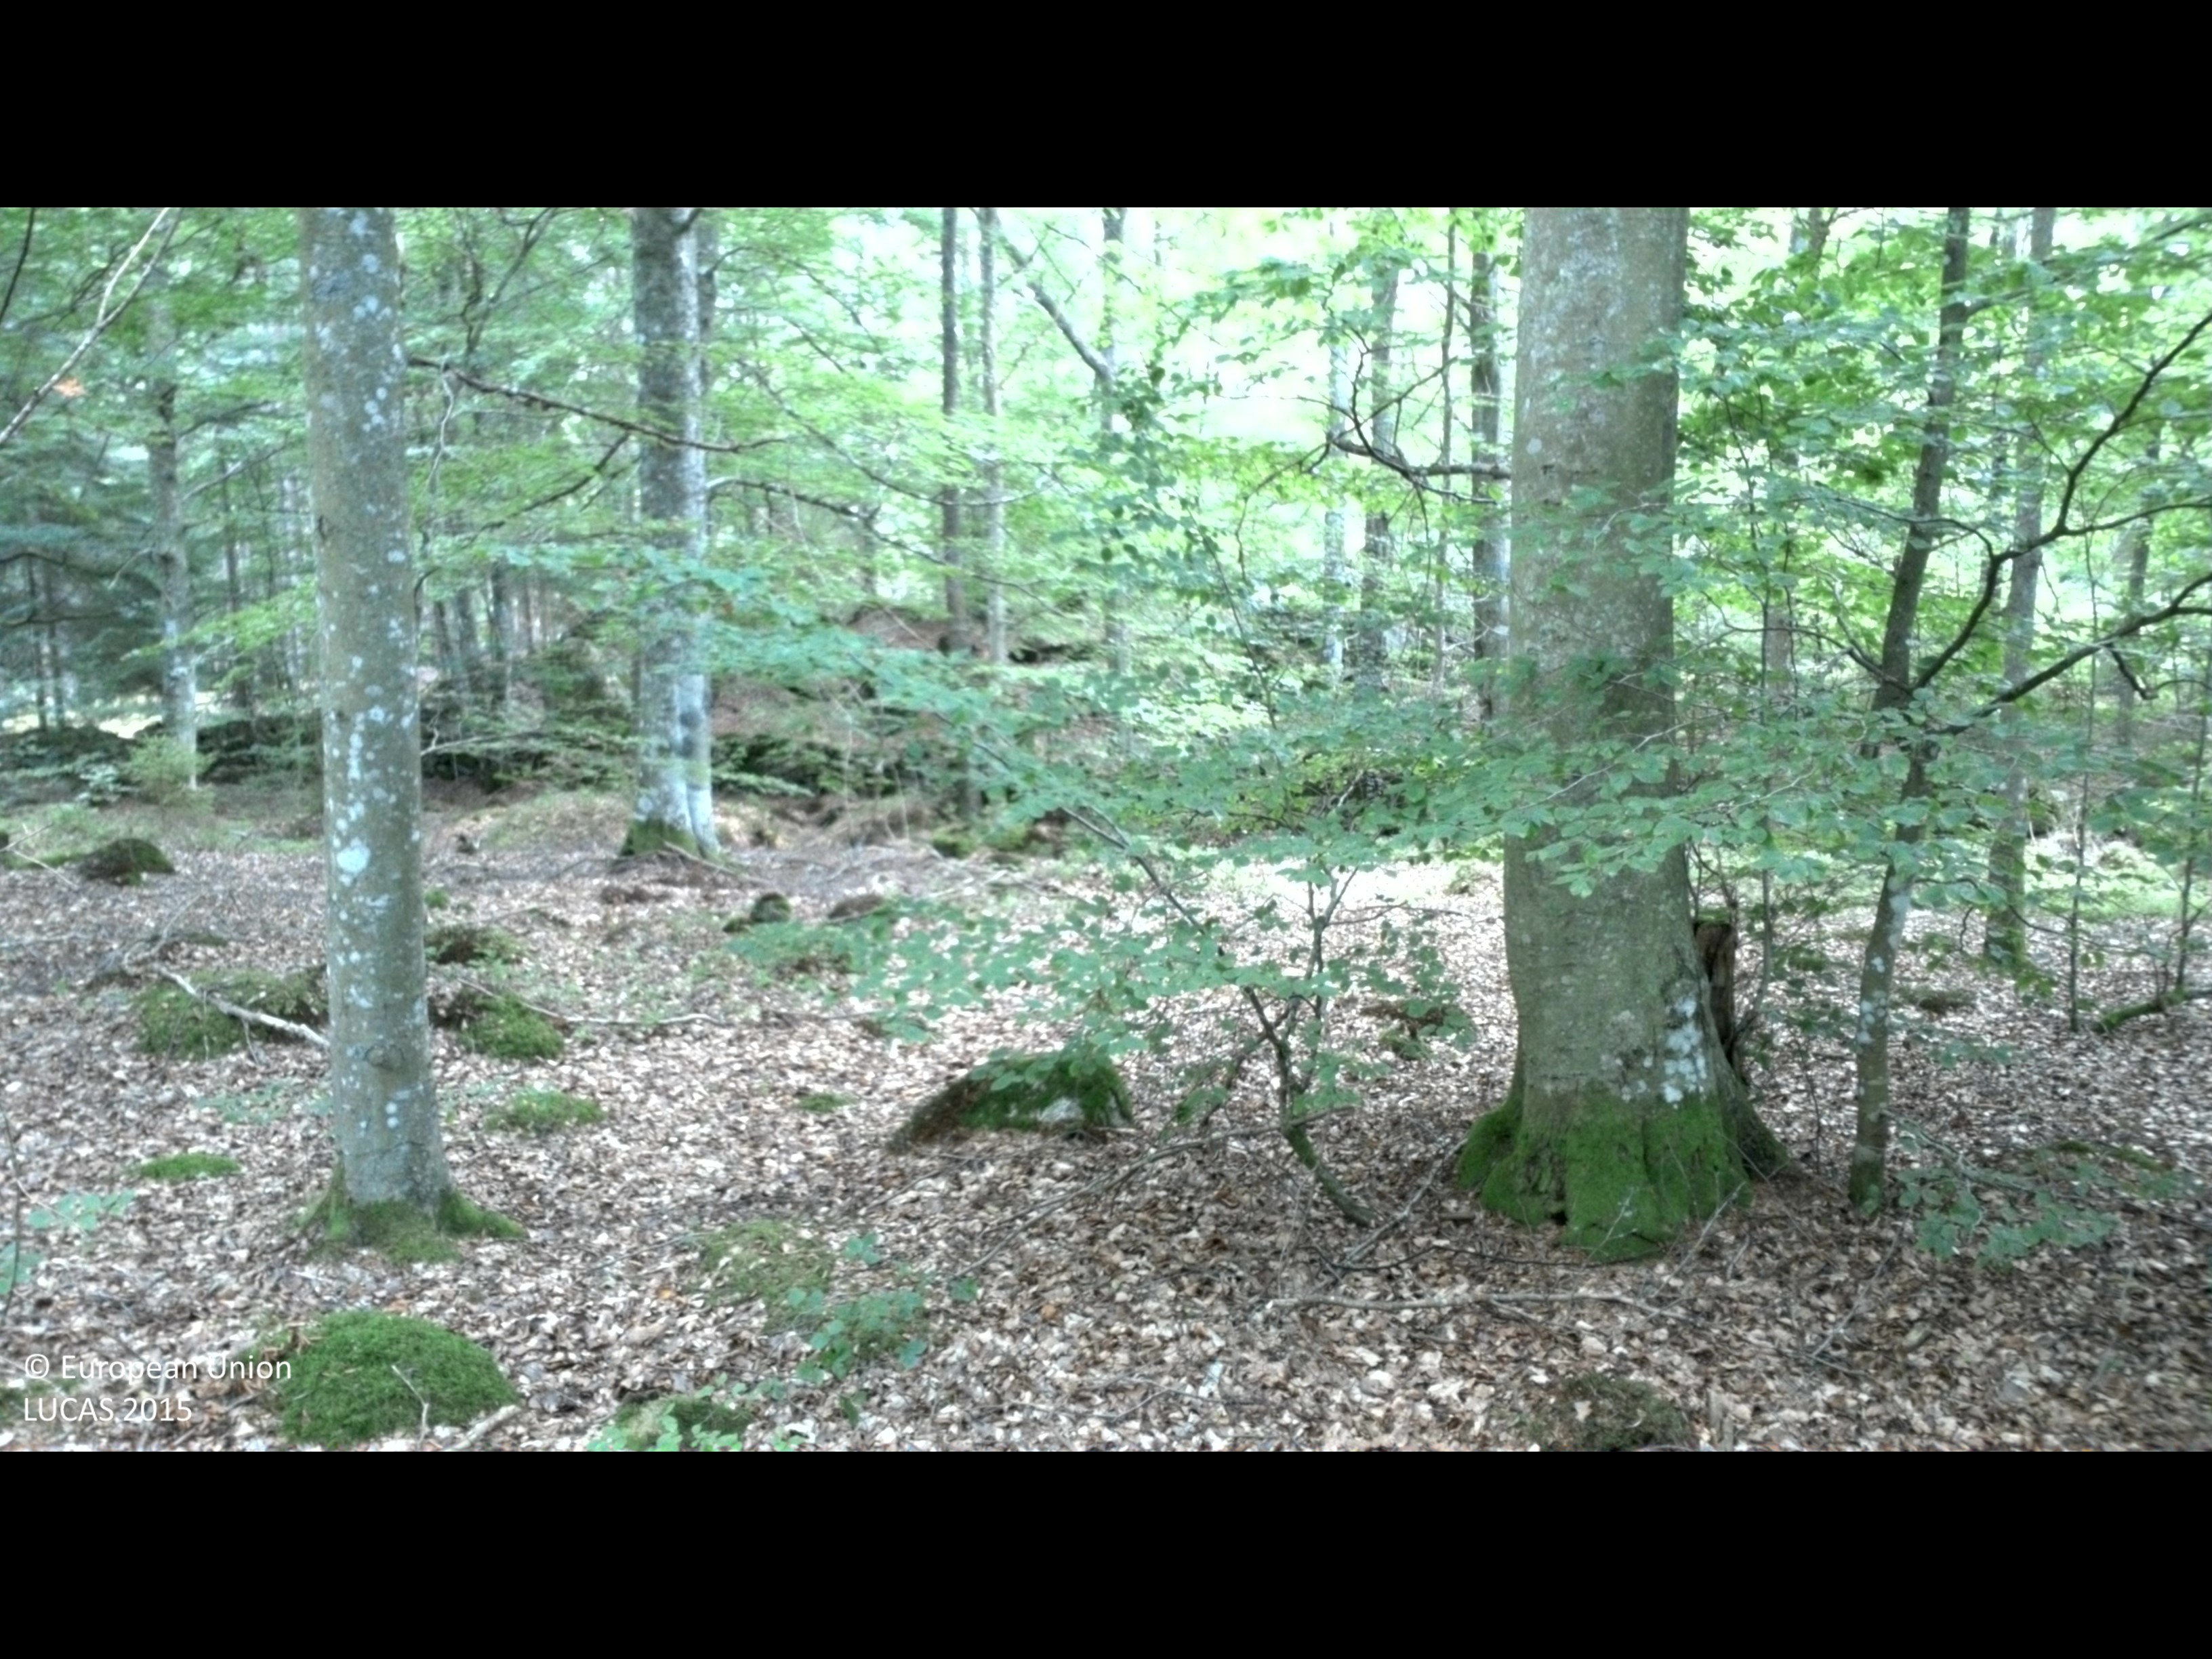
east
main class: Woodland
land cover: Broadleaved woodland
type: beech forest
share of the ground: > 75 %
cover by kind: broadleaved forest trees 75 %, lichens and mosses 10 %, shrubs 5 %
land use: Amenities, museums, leisure
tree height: > 5 m
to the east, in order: Broadleaved woodland; Dry stone walls; Spruce dominated coniferous woodland; Broadleaved woodland; Rivers and streams; Broadleaved woodland; Electric lines; Broadleaved woodland; Tracks; Broadleaved woodland
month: August
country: SE
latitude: 56.2529
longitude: 14.5011
